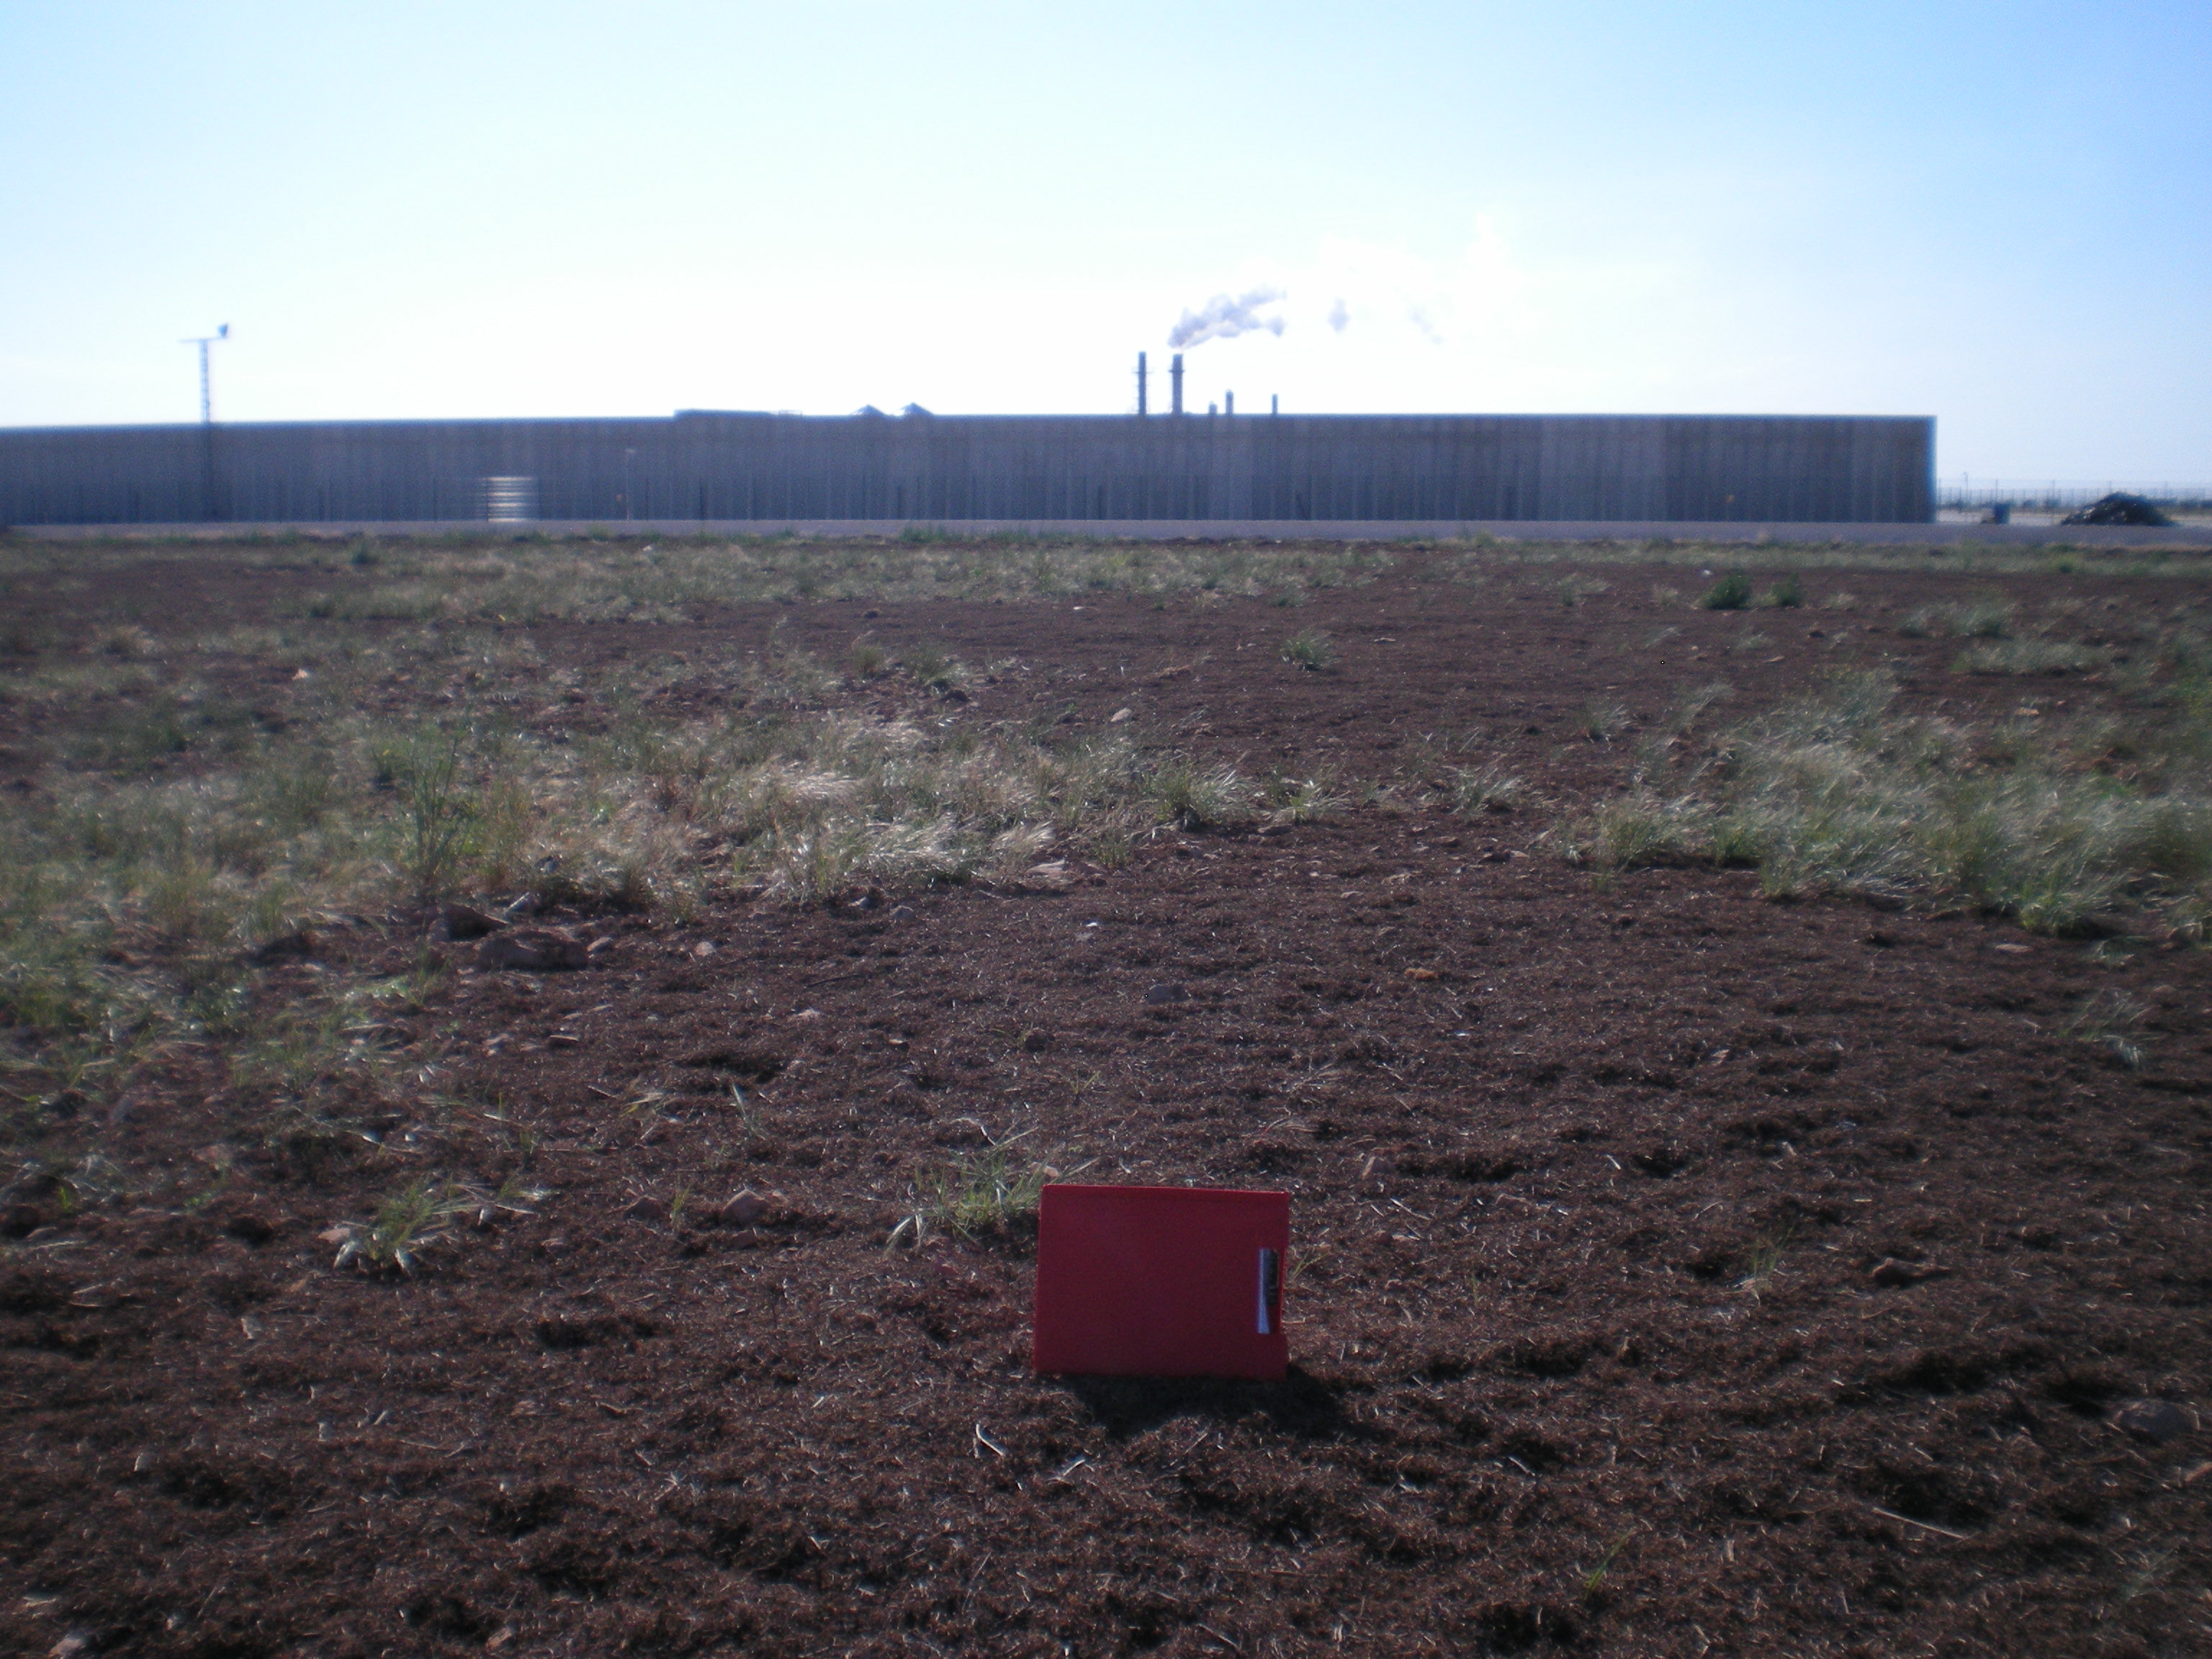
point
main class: Grassland
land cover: Spontaneously vegetated surfaces
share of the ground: 10 - 25 %
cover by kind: unconsolidated bare surface 85 %, herbaceous plants 15 %
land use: Agriculture (excluding fallow land and kitchen gardens)
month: May
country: ES
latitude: 39.0238
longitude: -3.5889
